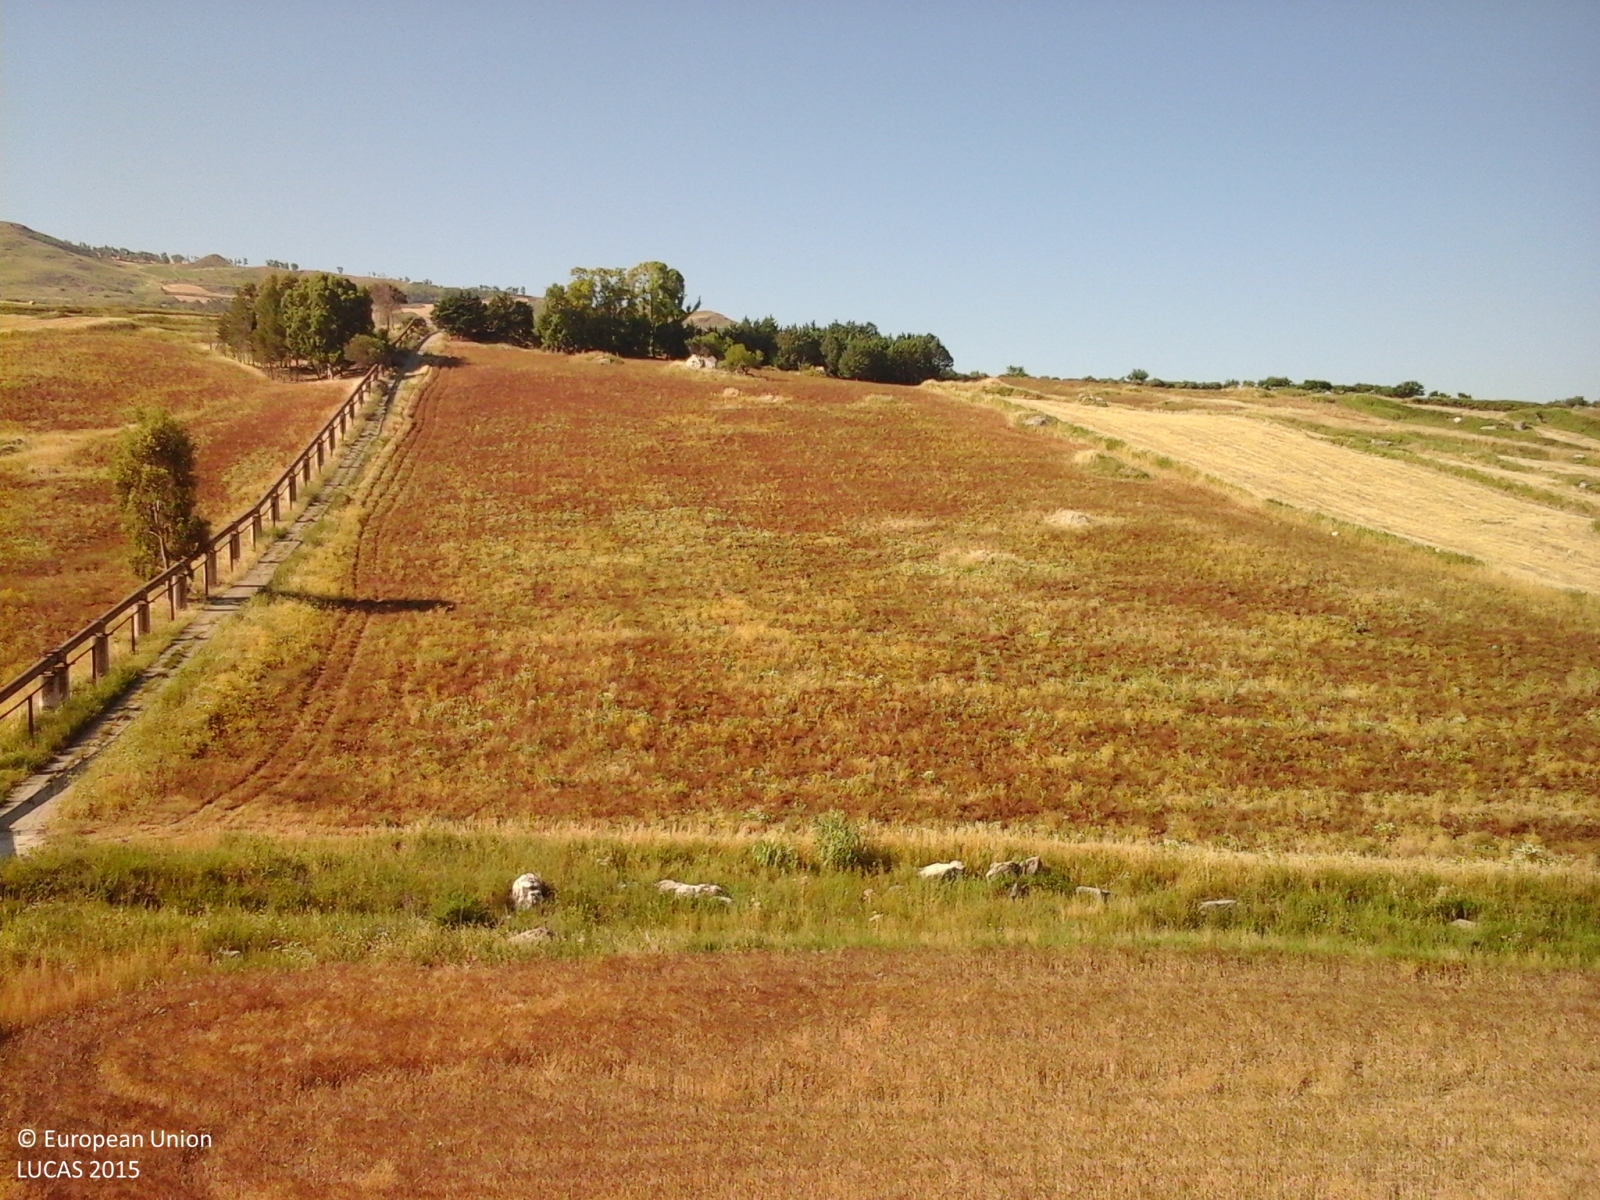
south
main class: Cropland
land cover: Durum wheat
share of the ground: > 75 %
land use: Agriculture (excluding fallow land and kitchen gardens)
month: July
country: IT
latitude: 37.5545
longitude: 13.5390
